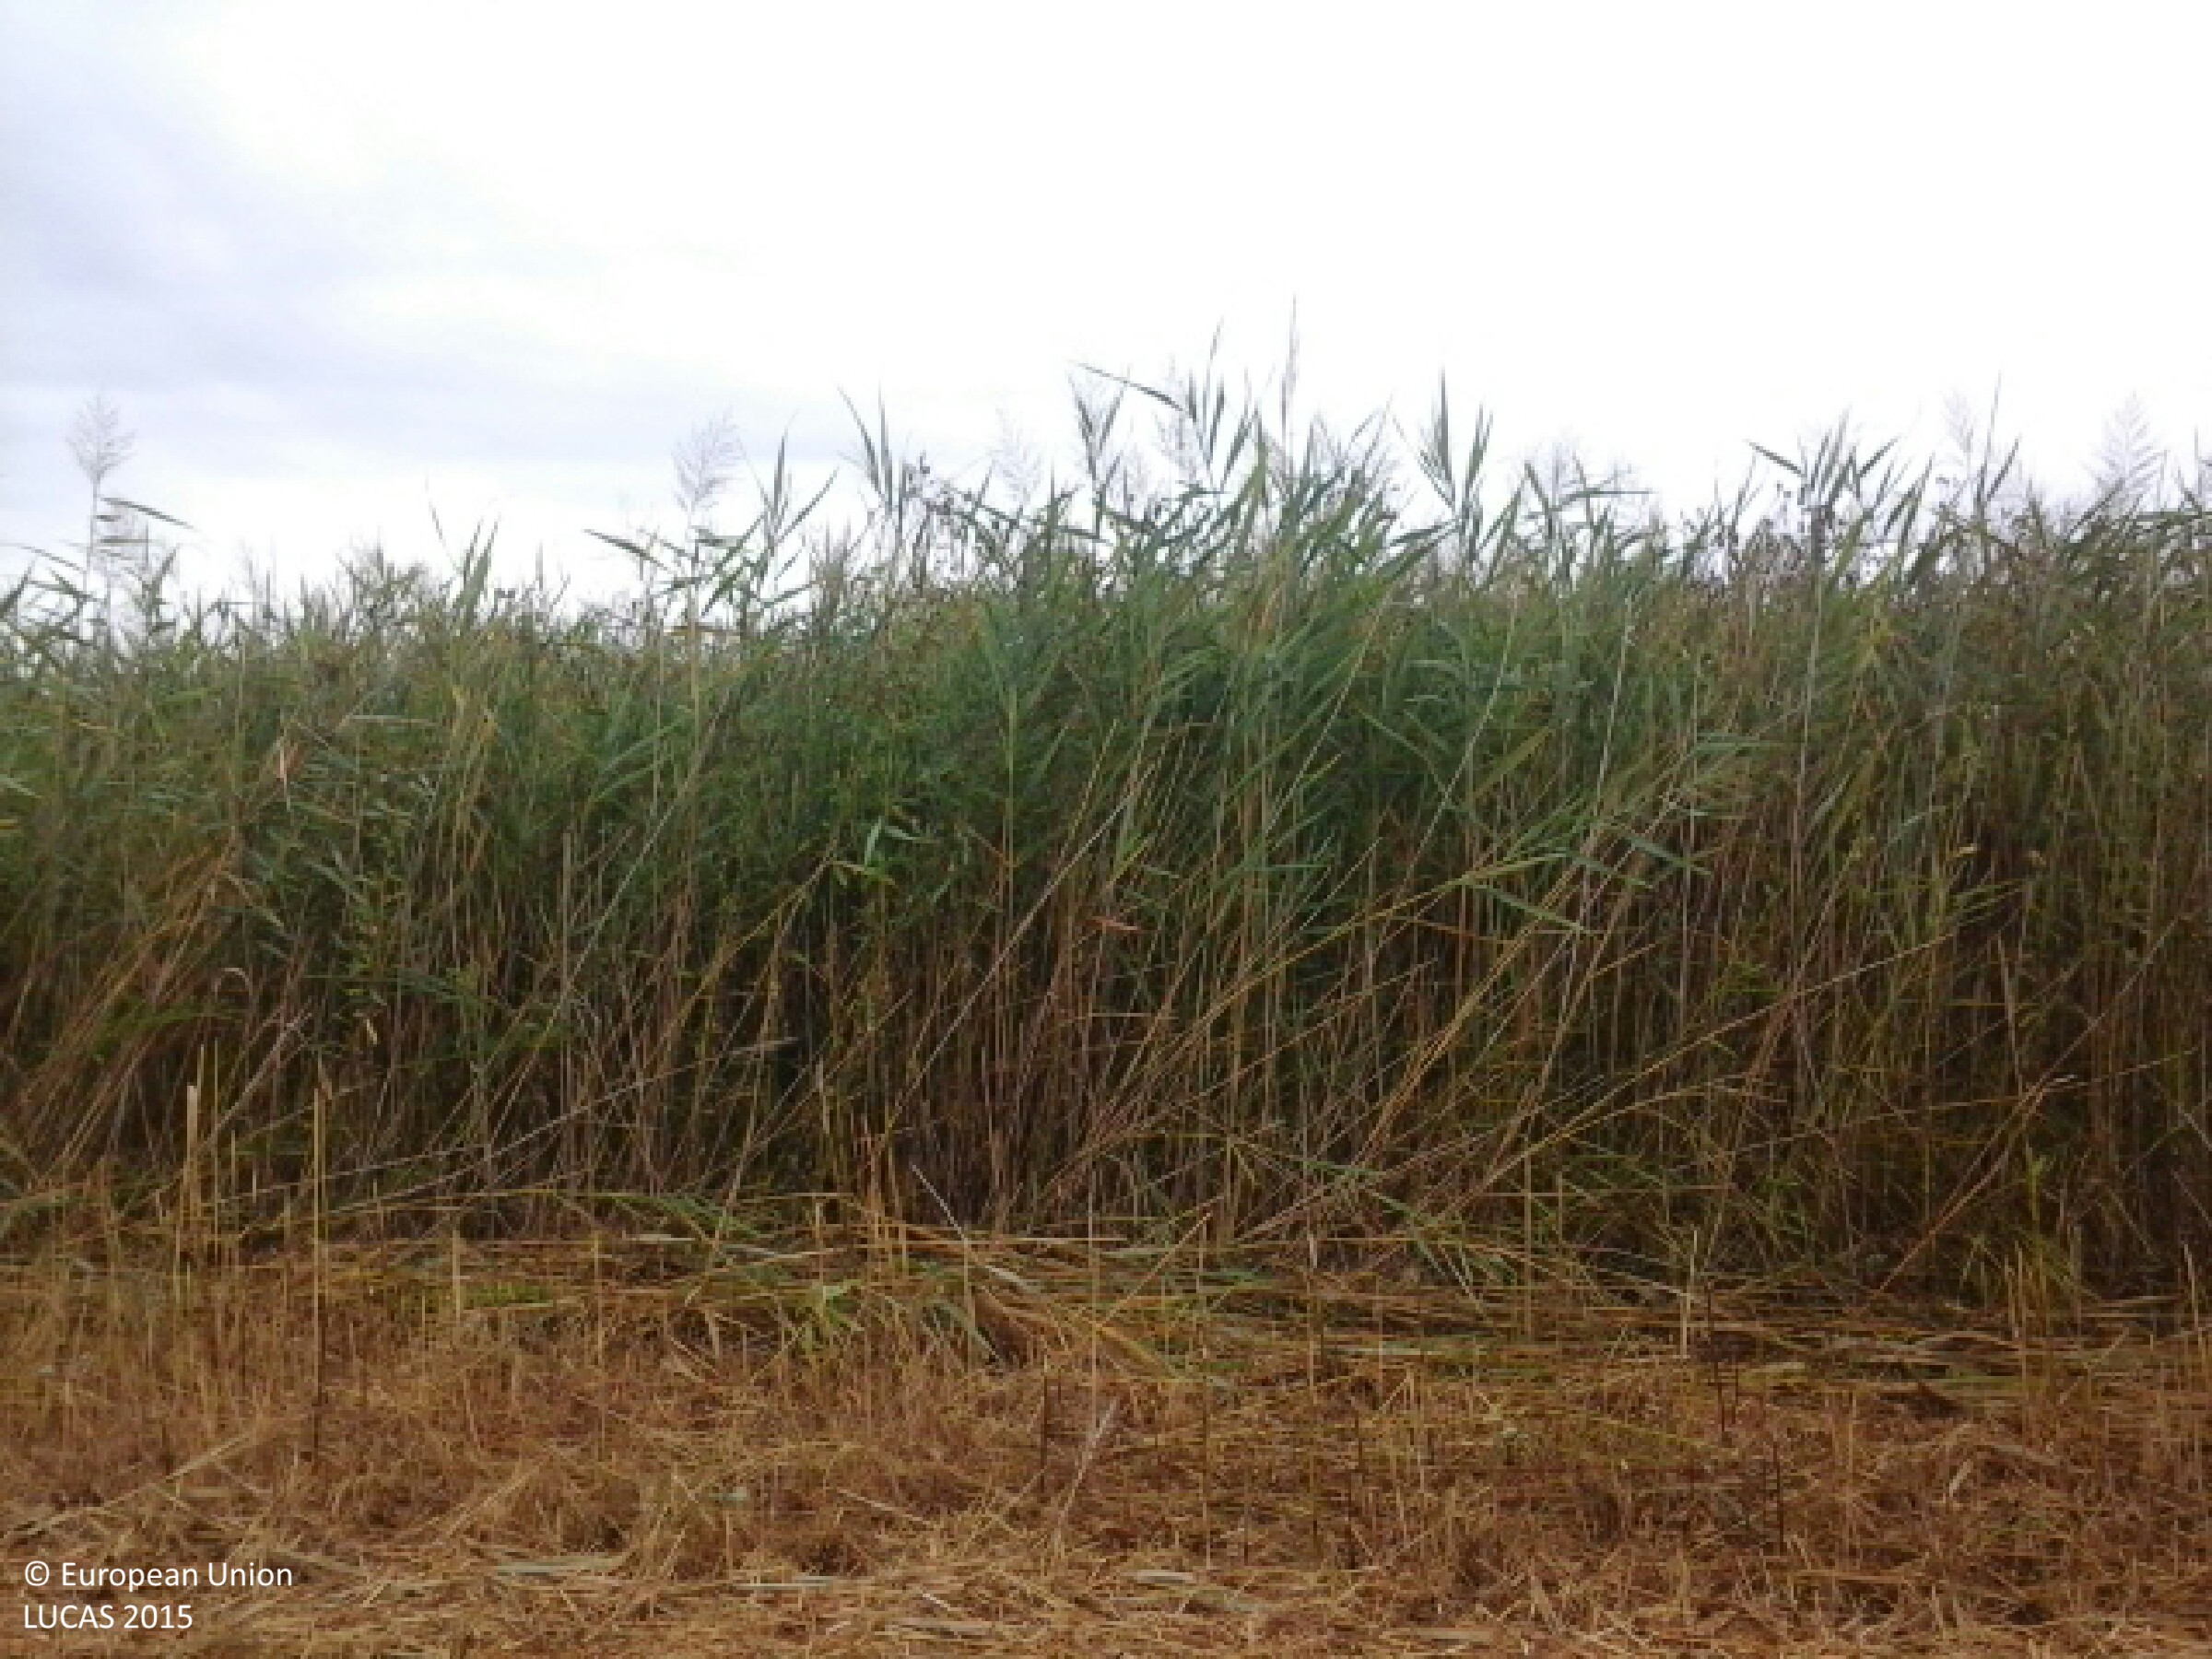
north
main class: Grassland
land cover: Grassland without tree/shrub cover
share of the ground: > 75 %
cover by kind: herbaceous plants 100 %
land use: Agriculture (excluding fallow land and kitchen gardens)
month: August
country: HU
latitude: 48.0390
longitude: 21.4861
